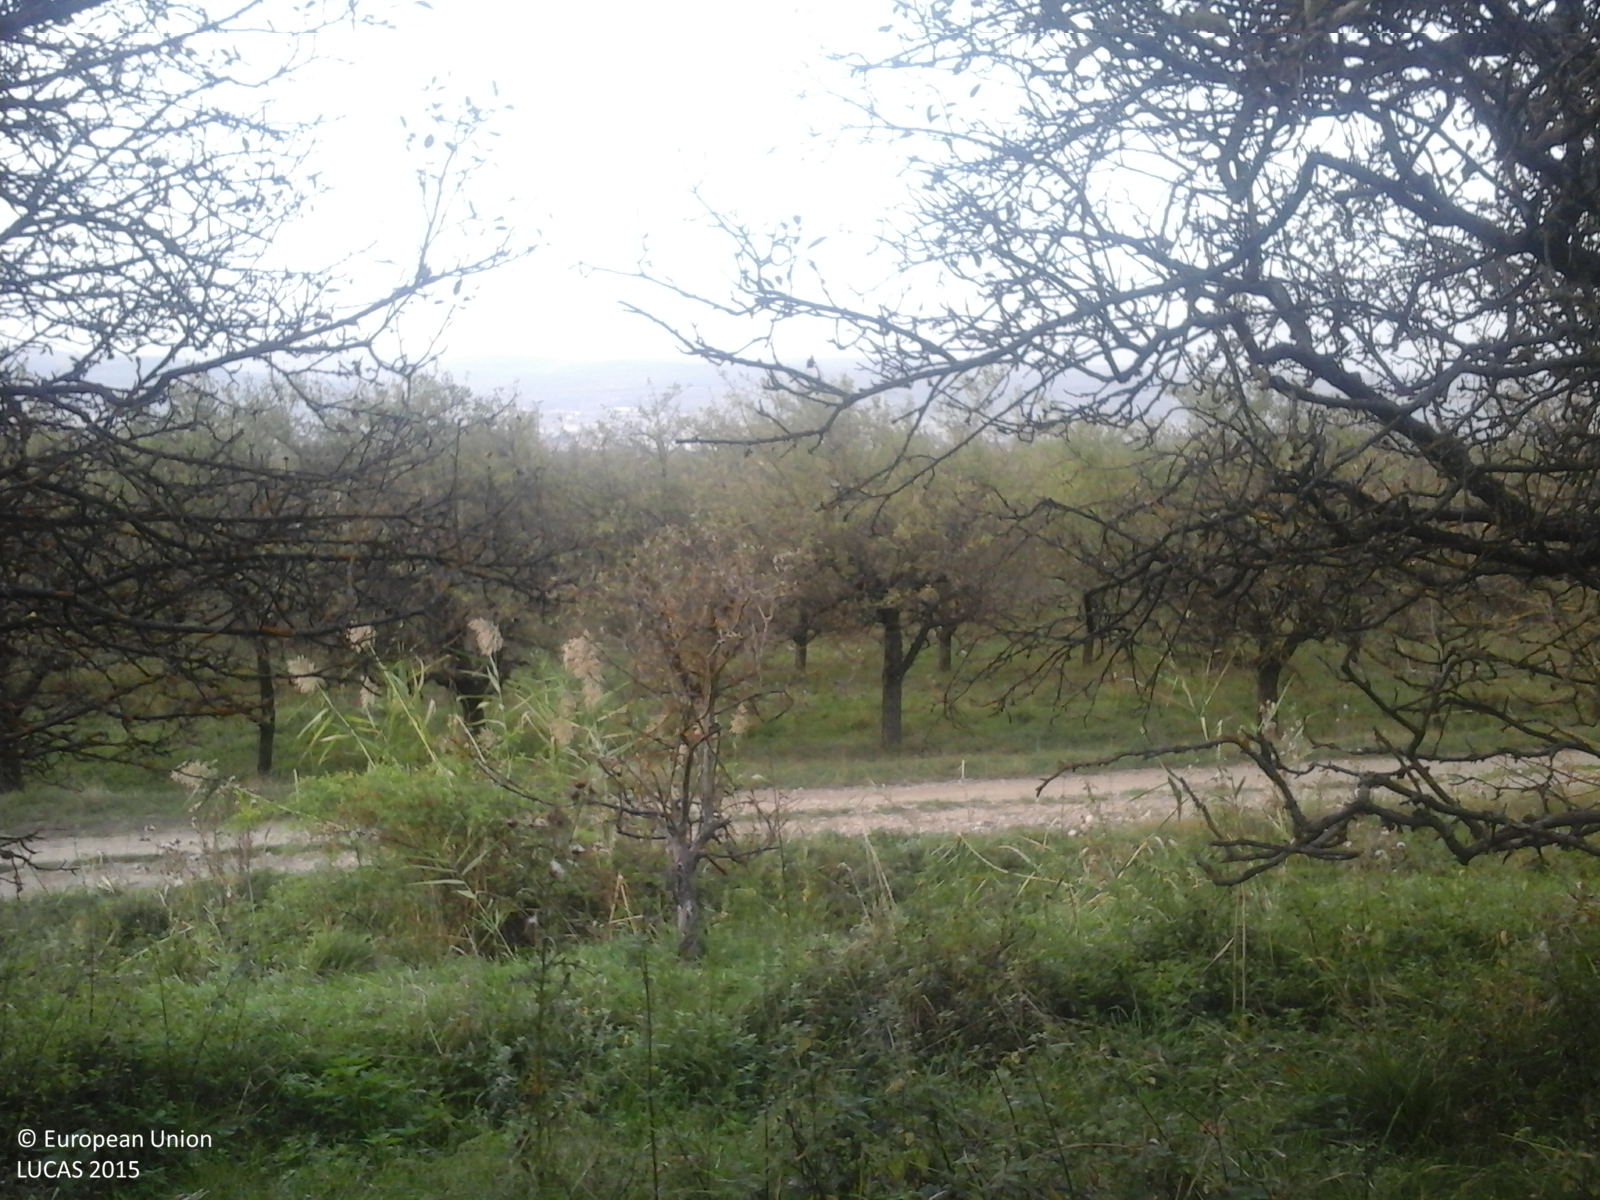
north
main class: Cropland
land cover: Apple fruit
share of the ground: > 75 %
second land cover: Grassland without tree/shrub cover
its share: > 75 %
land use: Agriculture (excluding fallow land and kitchen gardens)
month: September
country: RO
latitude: 46.7351
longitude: 23.6160
